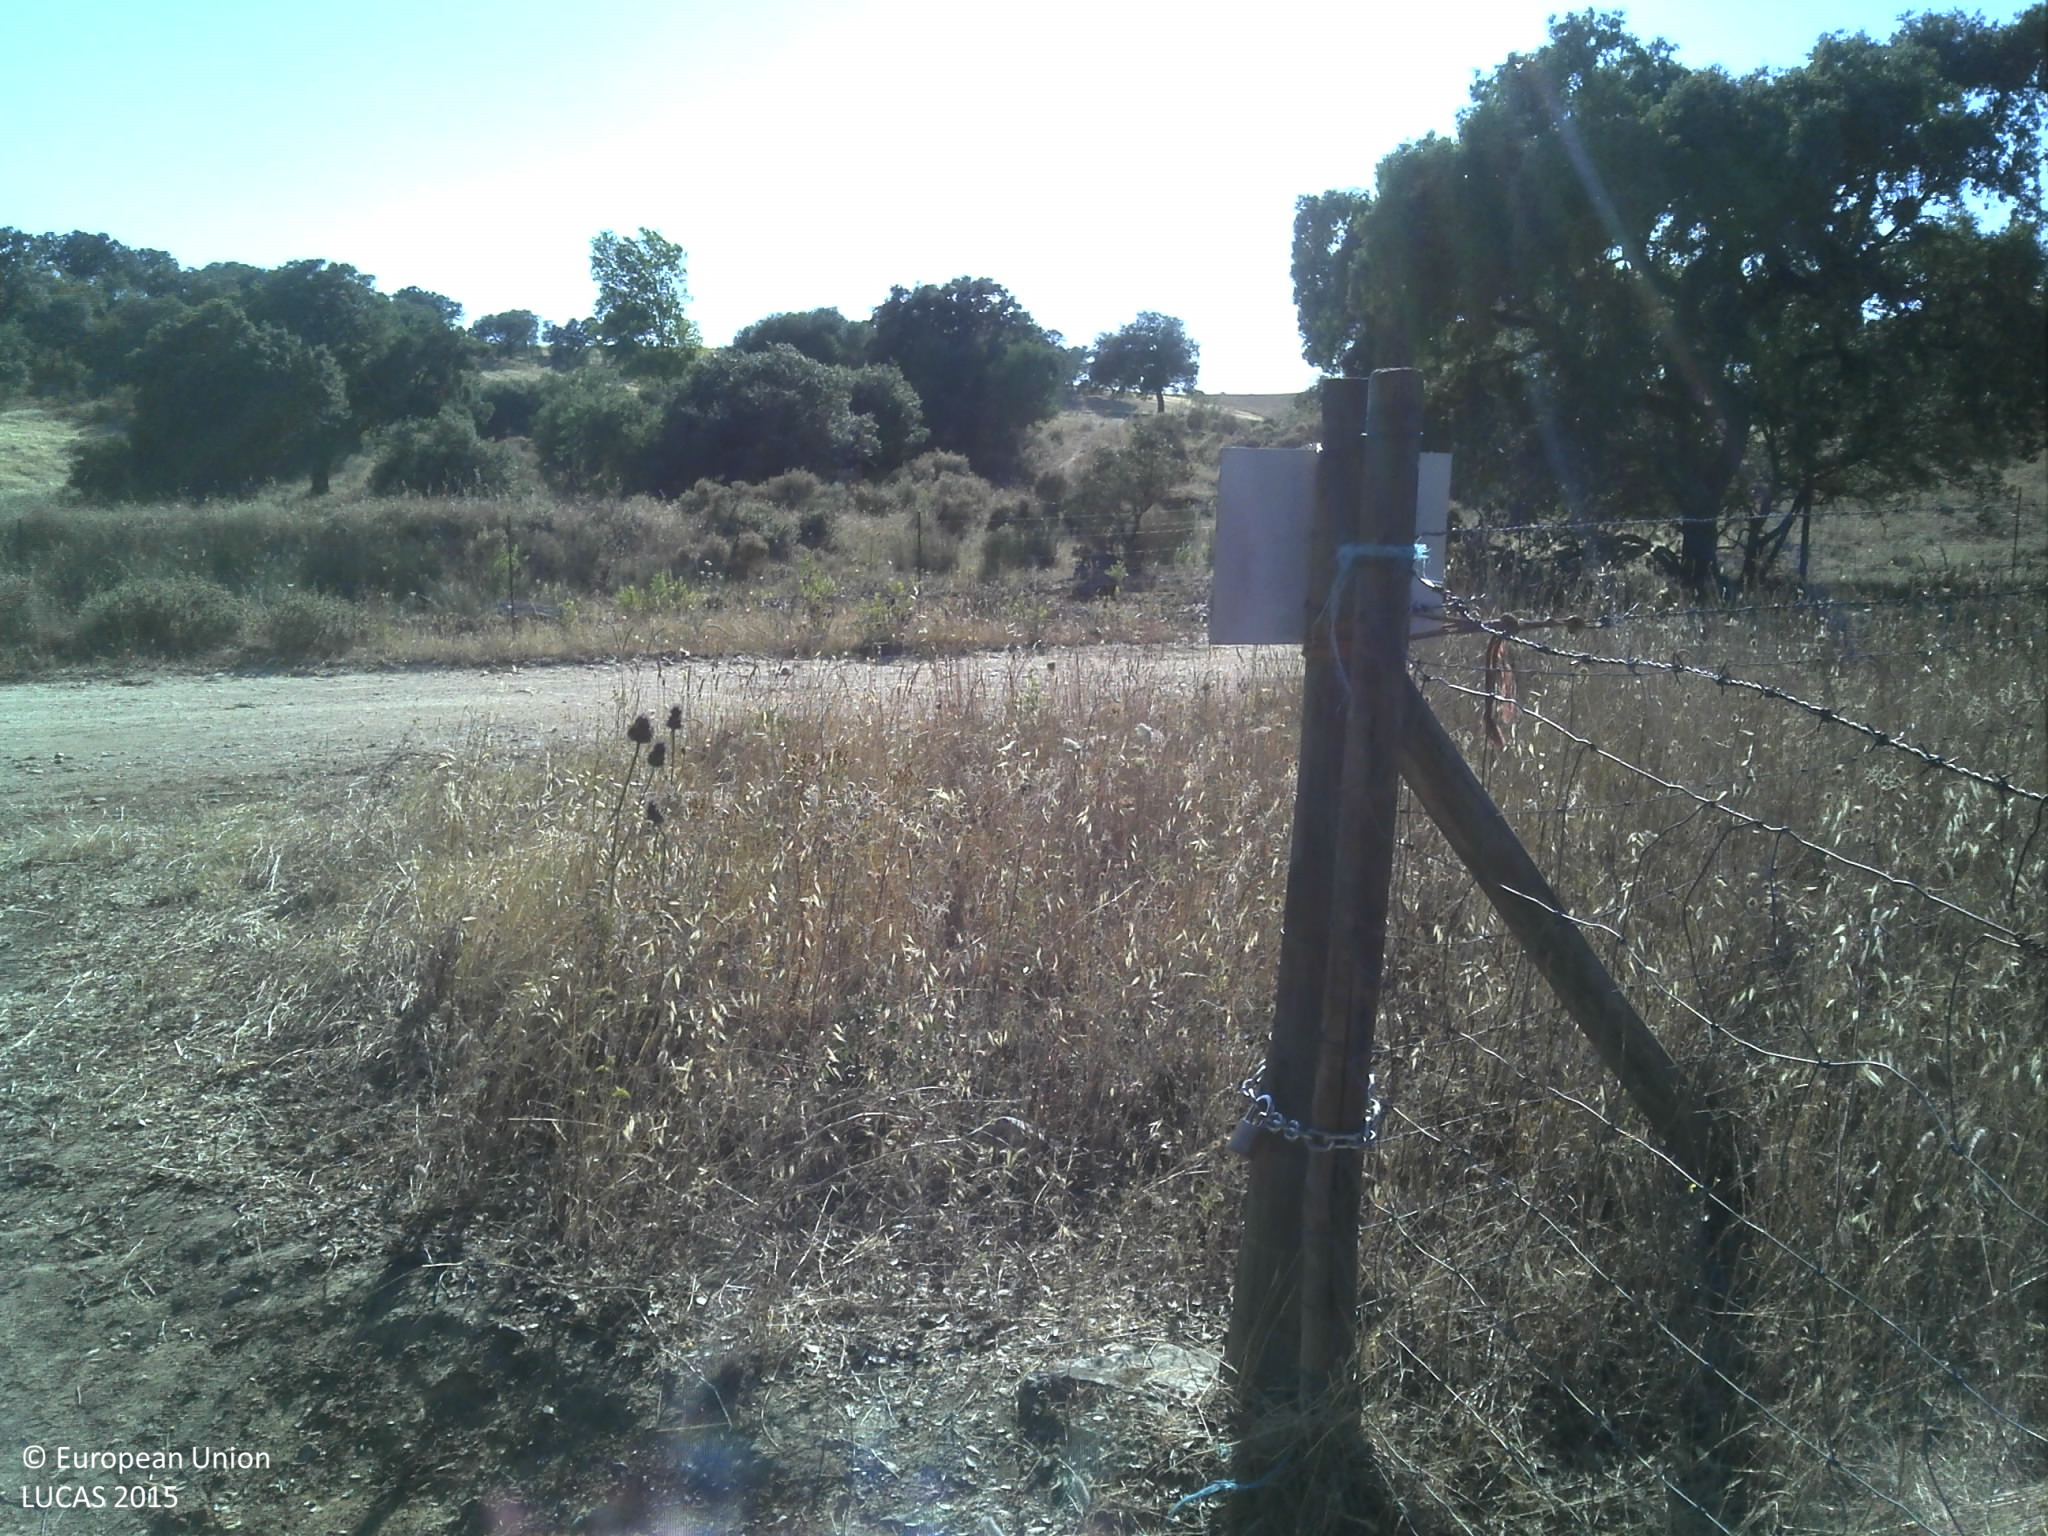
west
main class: Grassland
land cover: Grassland without tree/shrub cover
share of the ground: > 75 %
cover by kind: herbaceous plants 100 %
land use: Agriculture (excluding fallow land and kitchen gardens)
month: June
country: PT
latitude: 37.9773
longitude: -7.3075
